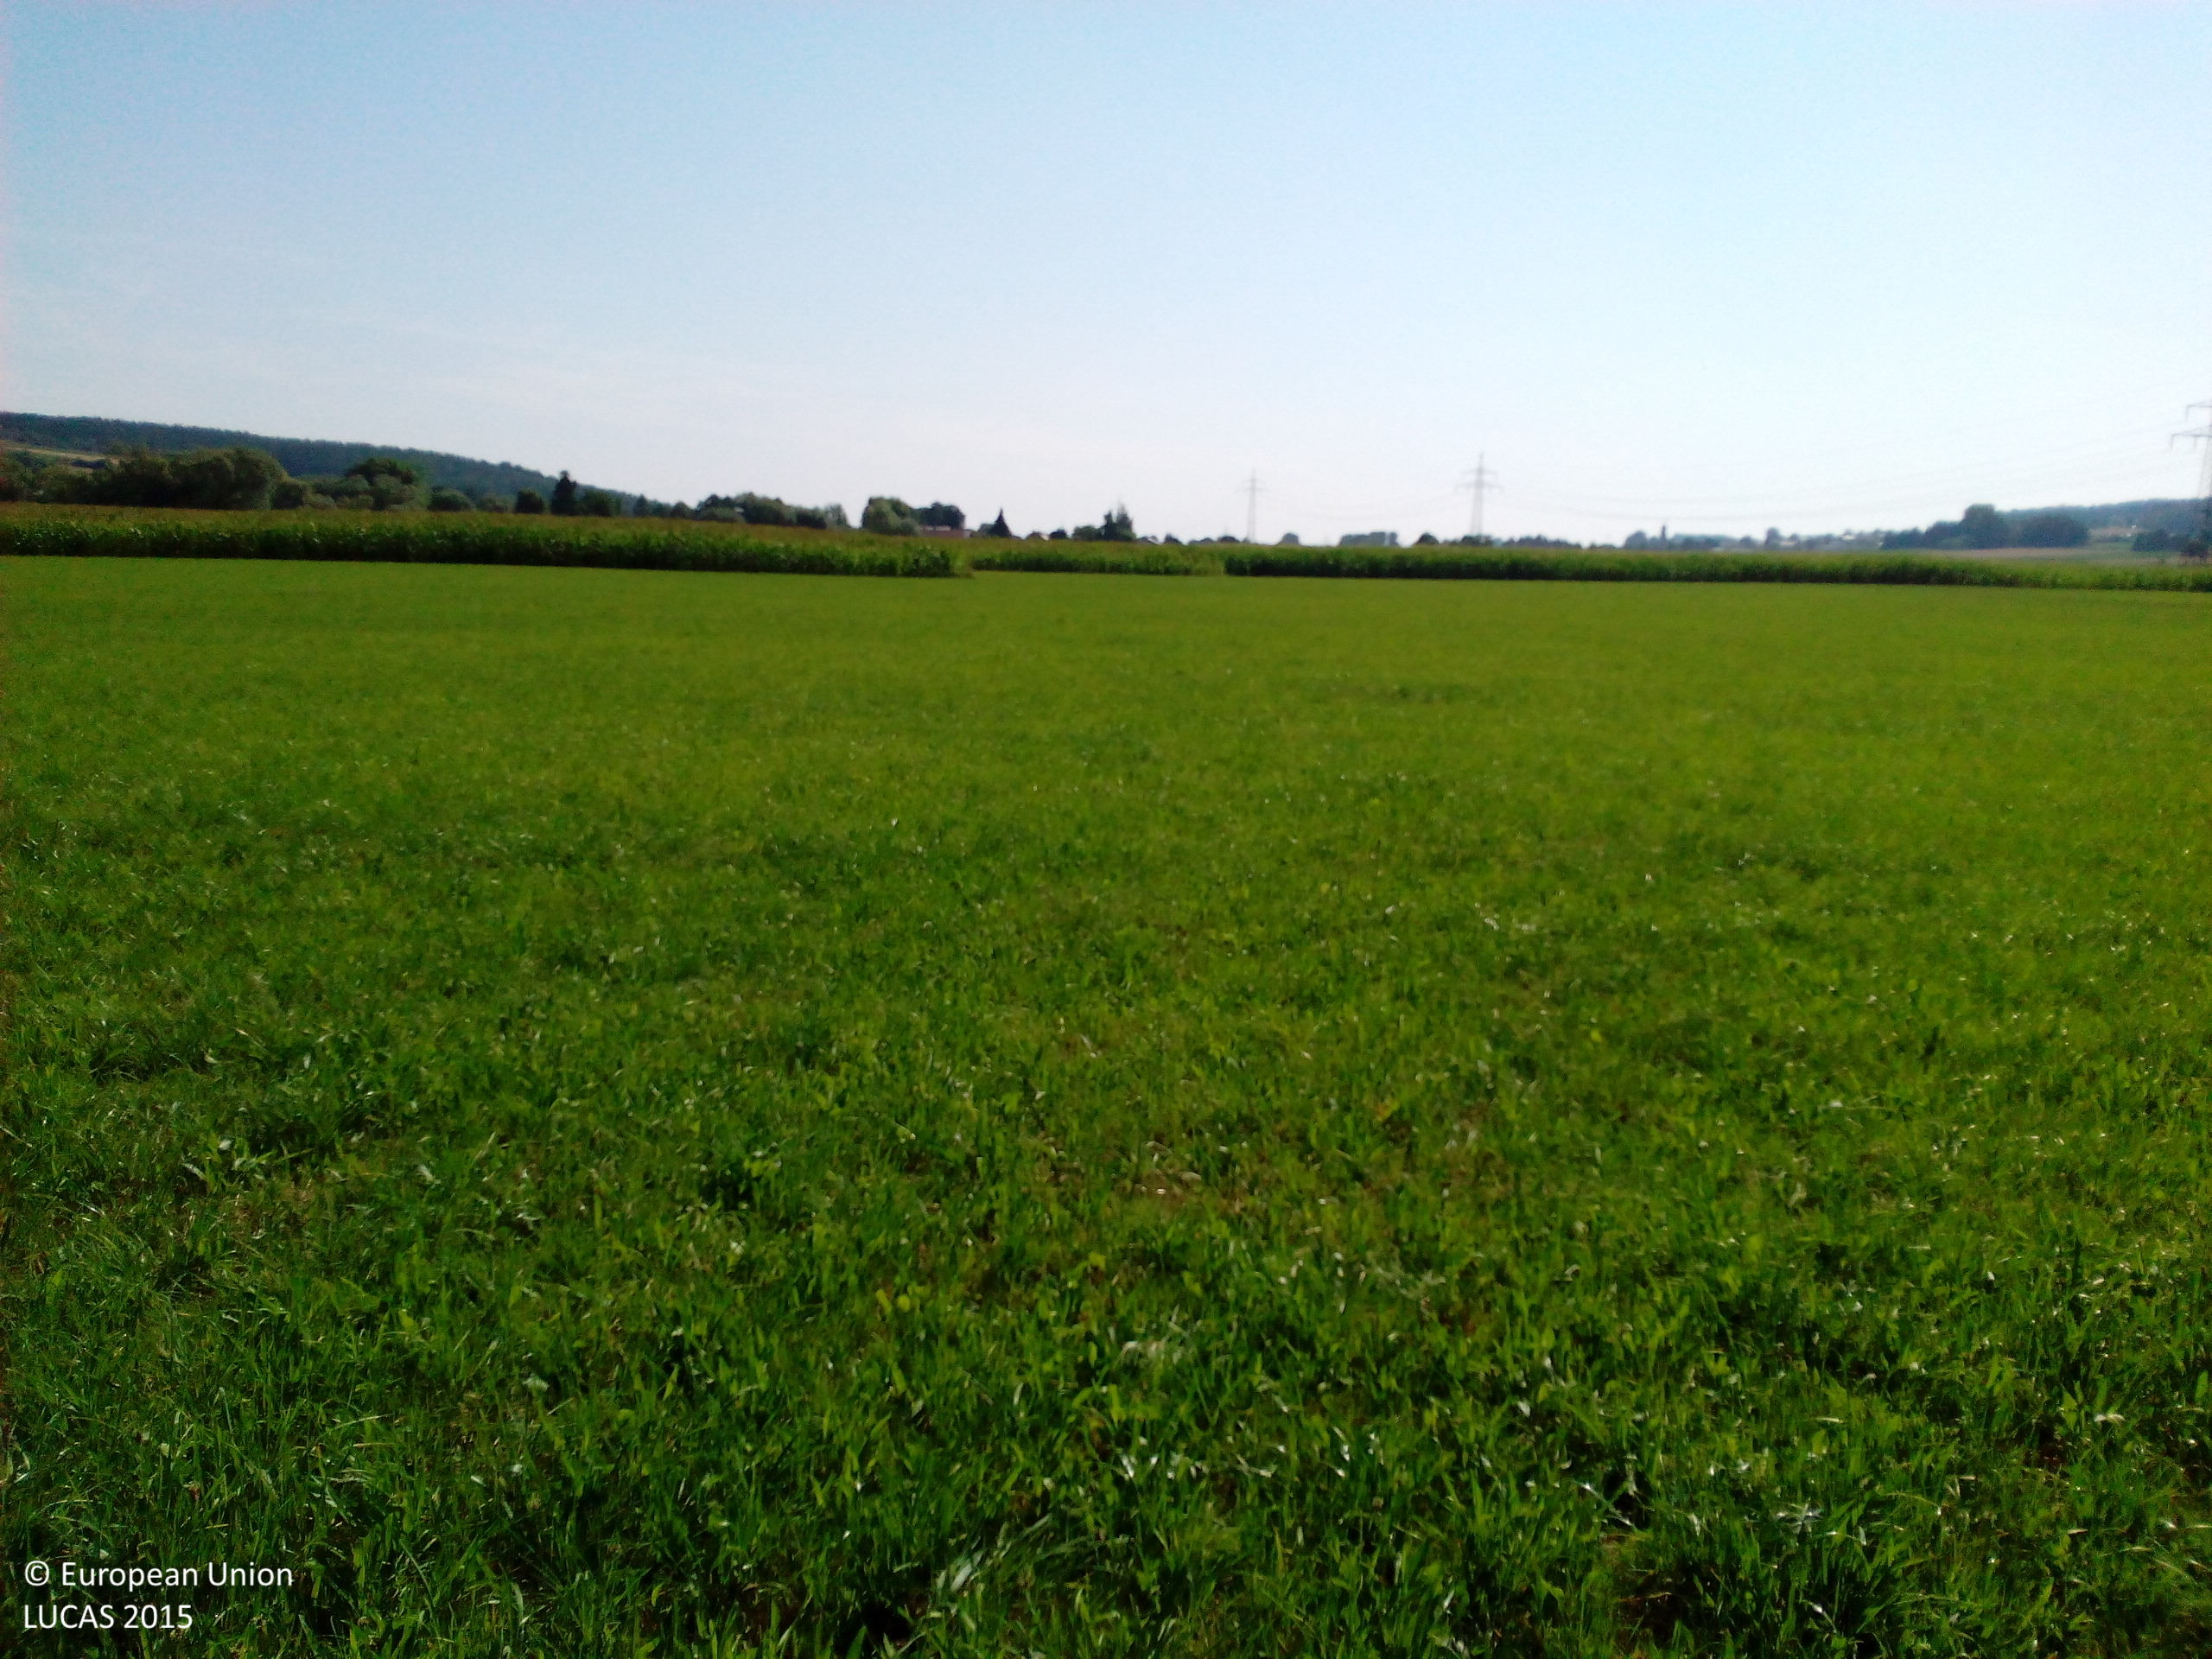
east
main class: Grassland
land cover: Grassland without tree/shrub cover
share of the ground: > 75 %
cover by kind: herbaceous plants 100 %
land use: Agriculture (excluding fallow land and kitchen gardens)
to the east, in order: Grassland without tree/shrub cover; Maize
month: July
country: DE
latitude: 48.5992
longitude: 12.9147
